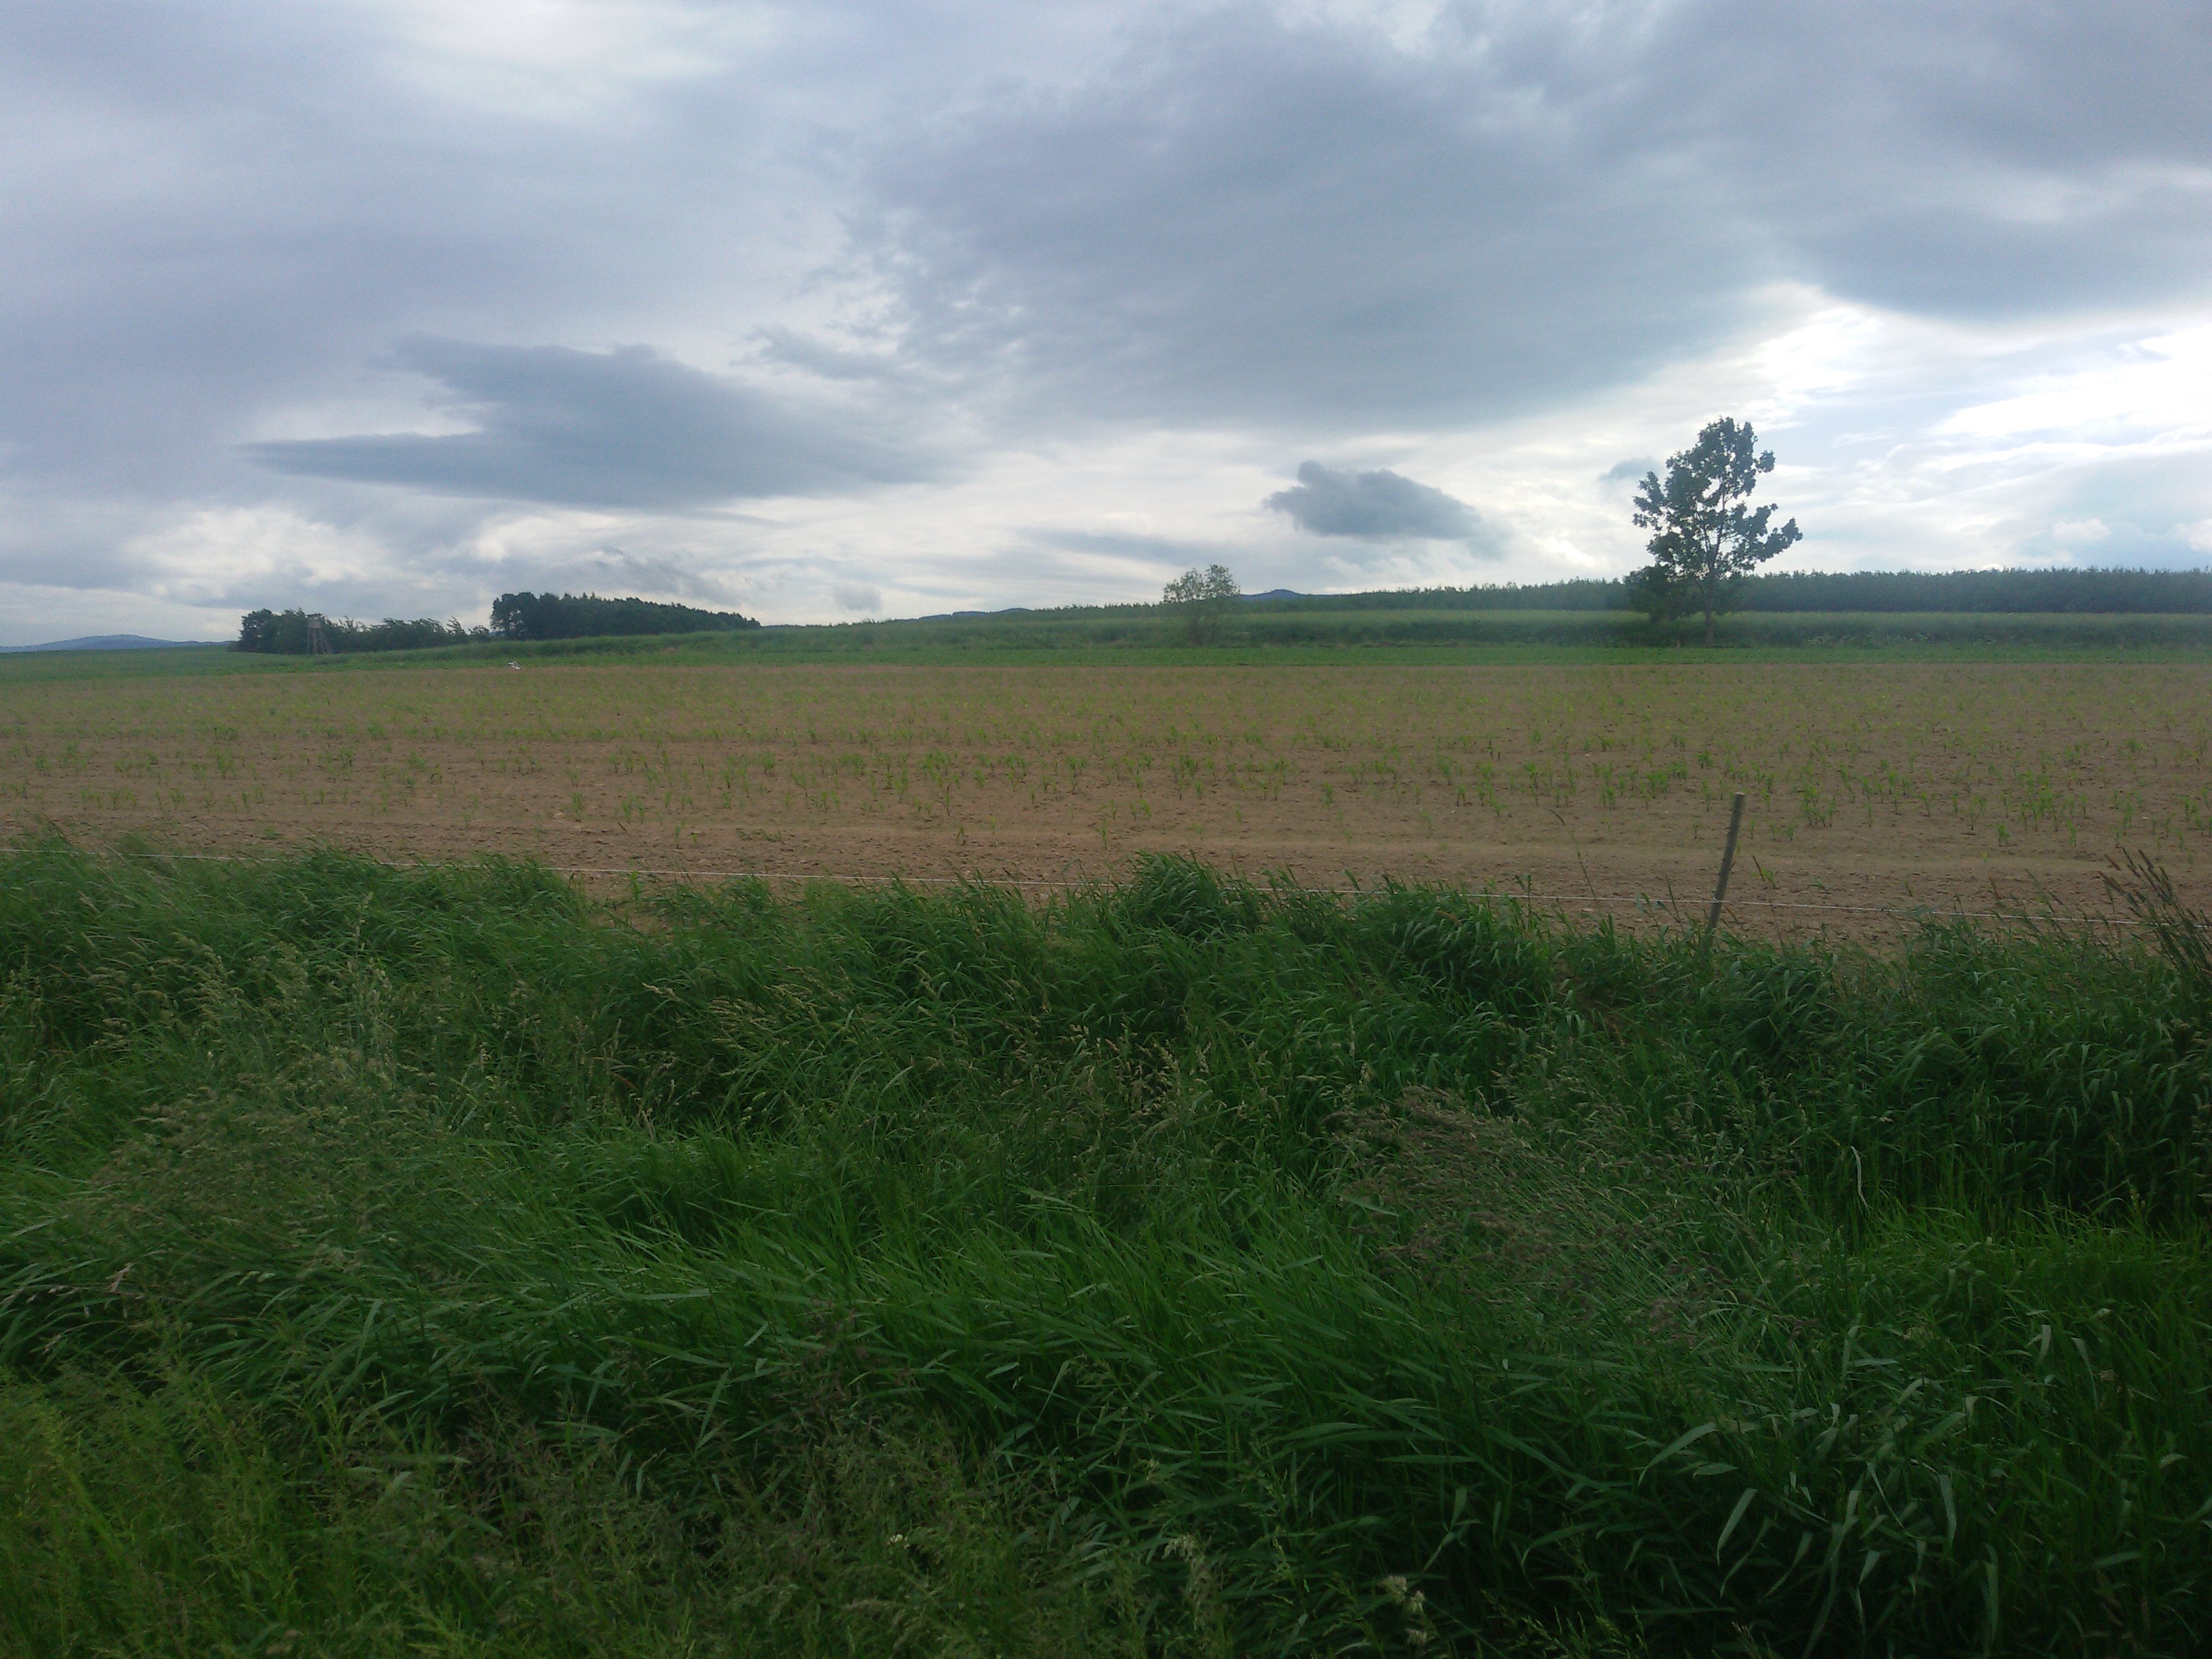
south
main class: Cropland
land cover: Rape and turnip rape
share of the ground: > 75 %
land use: Agriculture (excluding fallow land and kitchen gardens)
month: May
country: PL
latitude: 50.3881
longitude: 17.2265
